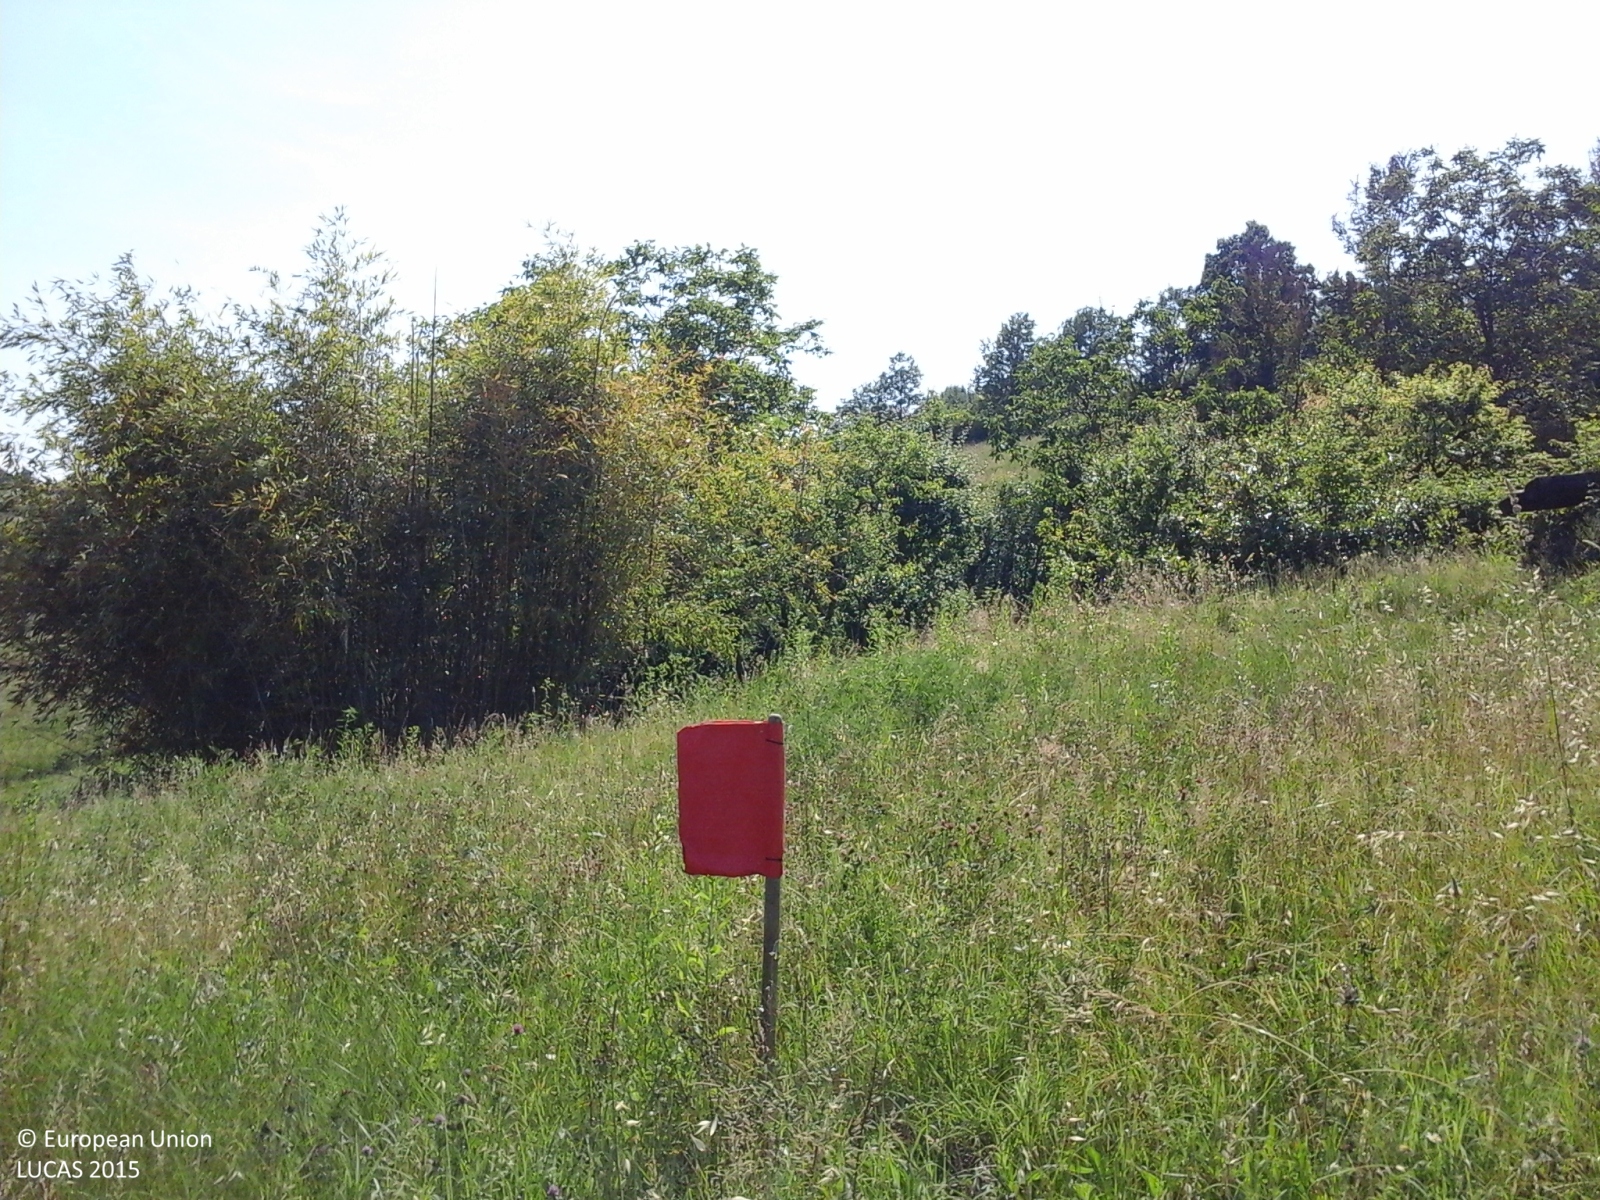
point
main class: Grassland
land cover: Grassland without tree/shrub cover
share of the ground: > 75 %
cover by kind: herbaceous plants 100 %
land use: Agriculture (excluding fallow land and kitchen gardens)
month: May
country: IT
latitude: 44.8194
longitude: 10.0126
